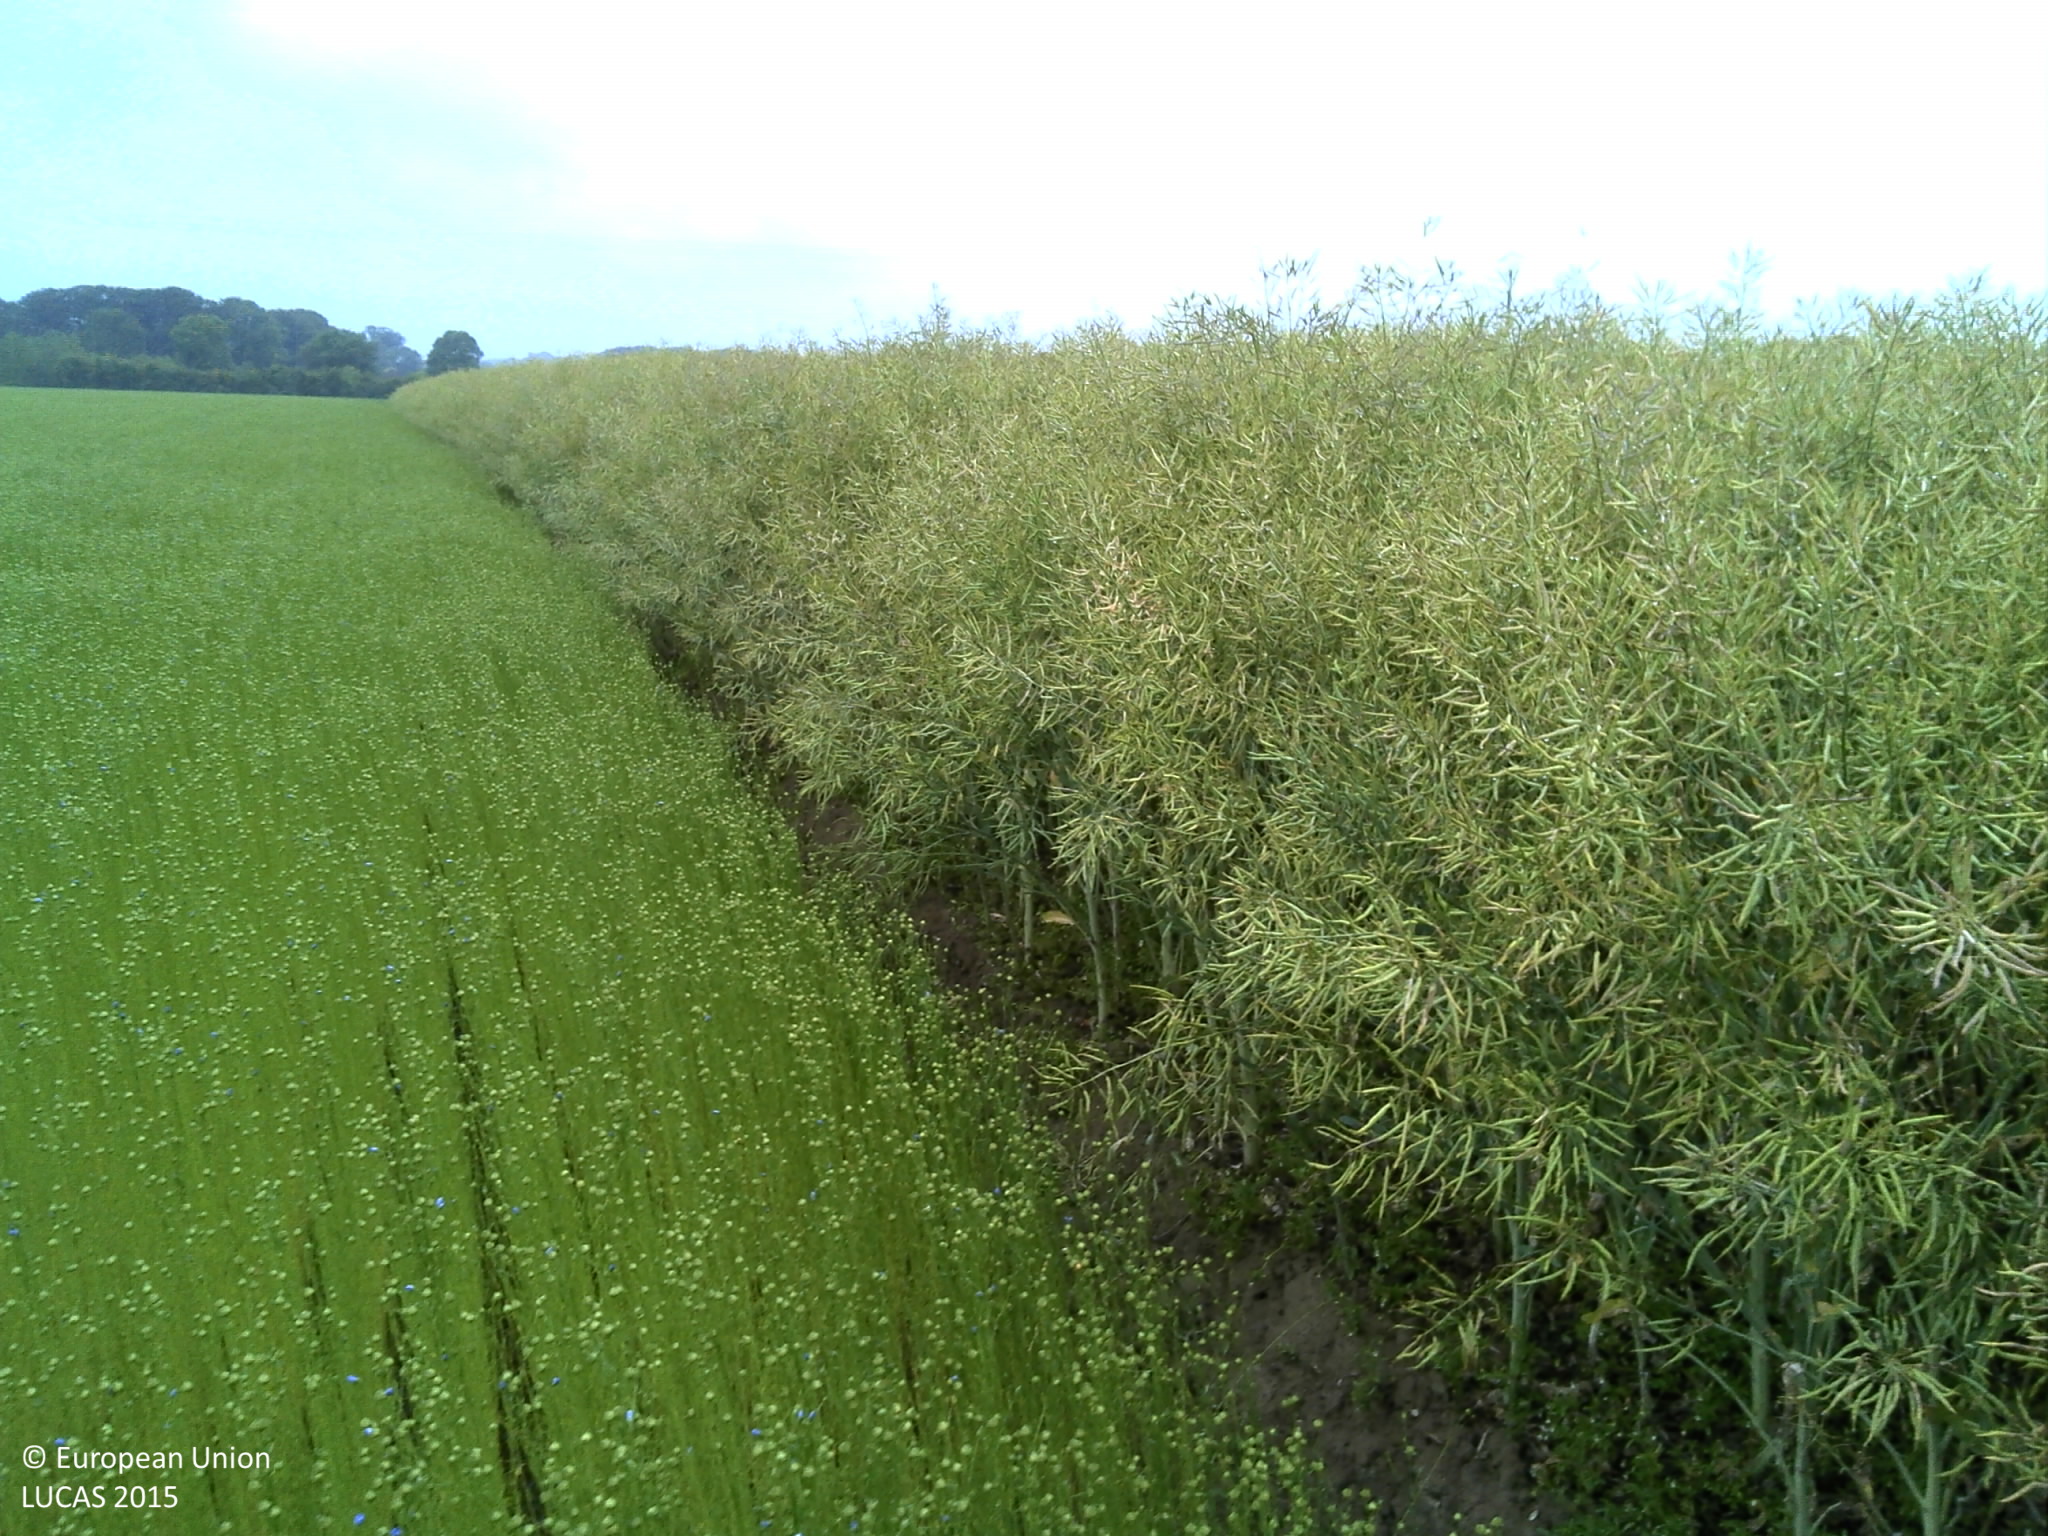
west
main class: Cropland
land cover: Rape and turnip rape
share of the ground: > 75 %
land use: Agriculture (excluding fallow land and kitchen gardens)
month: June
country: FR
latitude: 49.6980
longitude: 0.3079
